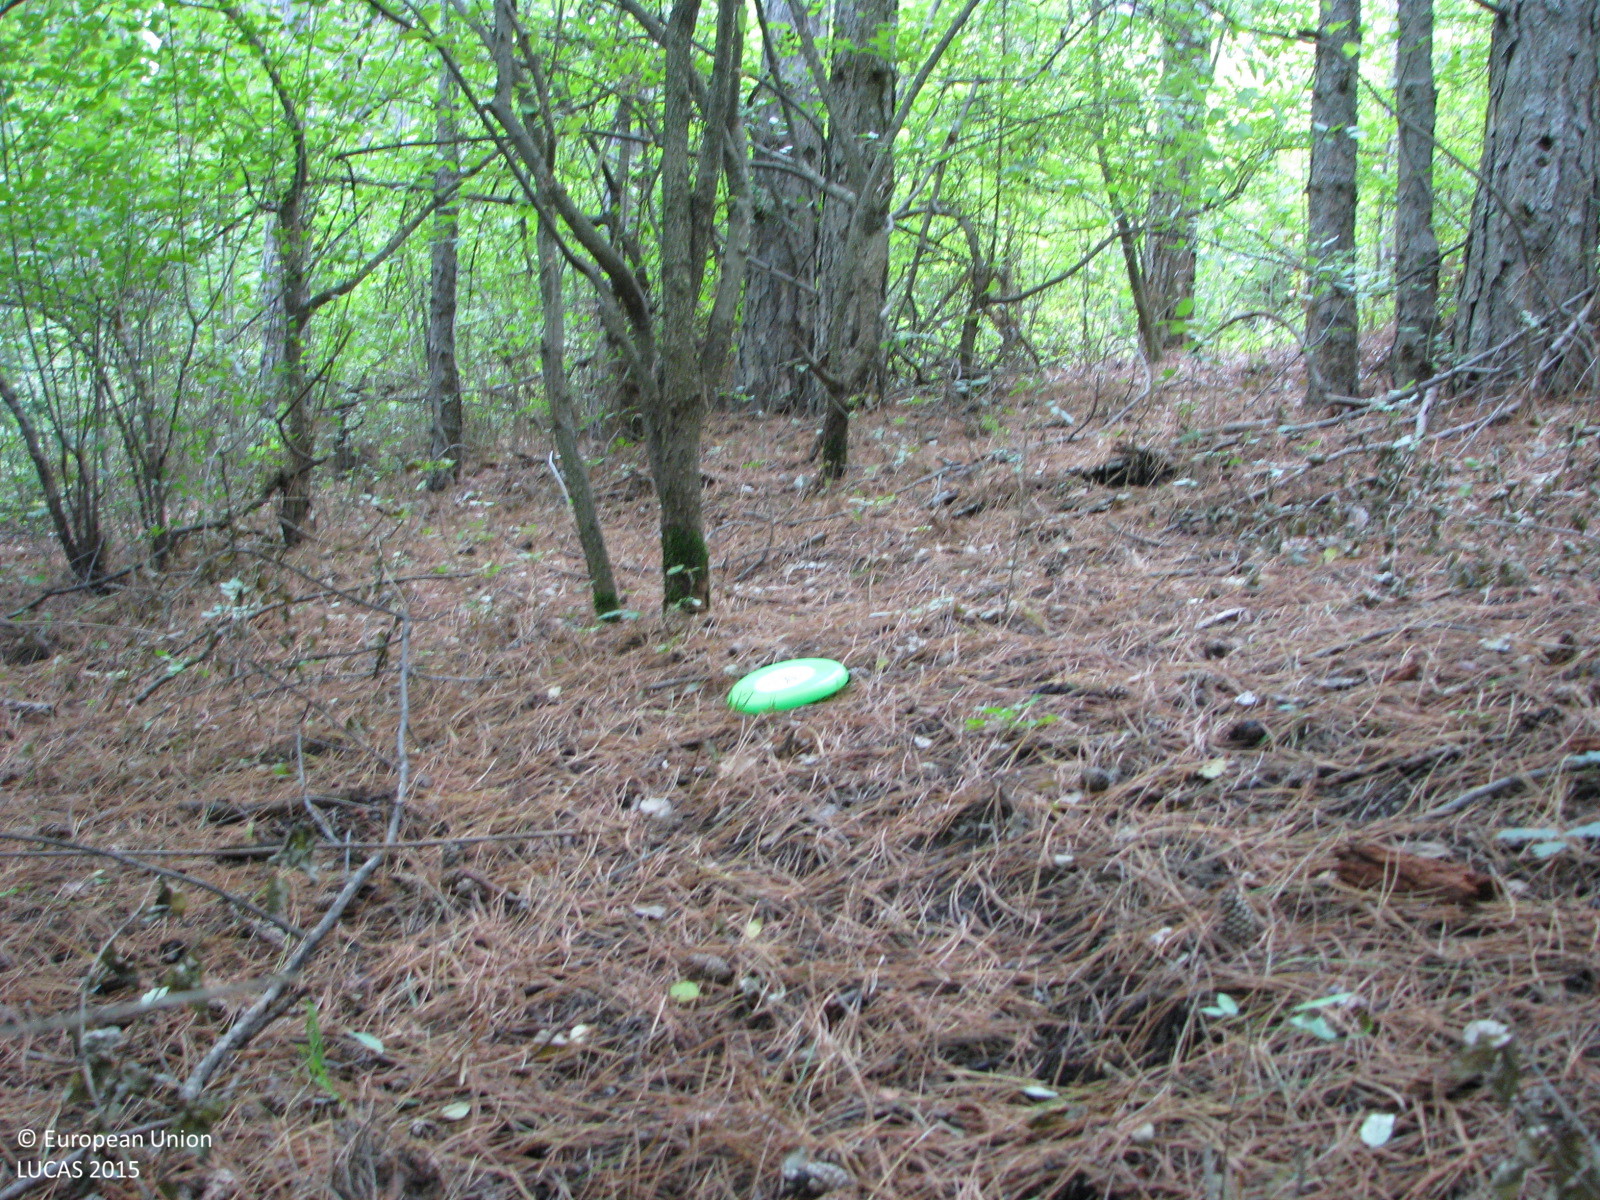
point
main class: Woodland
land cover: Pine dominated mixed woodland
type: hemiboreal forest and nemoral coniferous forest and mixed broadleaved-coniferous forest
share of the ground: > 75 %
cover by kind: coniferous forest trees 60 %, broadleaved forest trees 20 %, shrubs 10 %, unconsolidated bare surface 10 %
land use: Forestry
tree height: > 5 m
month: September
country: BG
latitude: 42.6997
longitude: 26.3142
